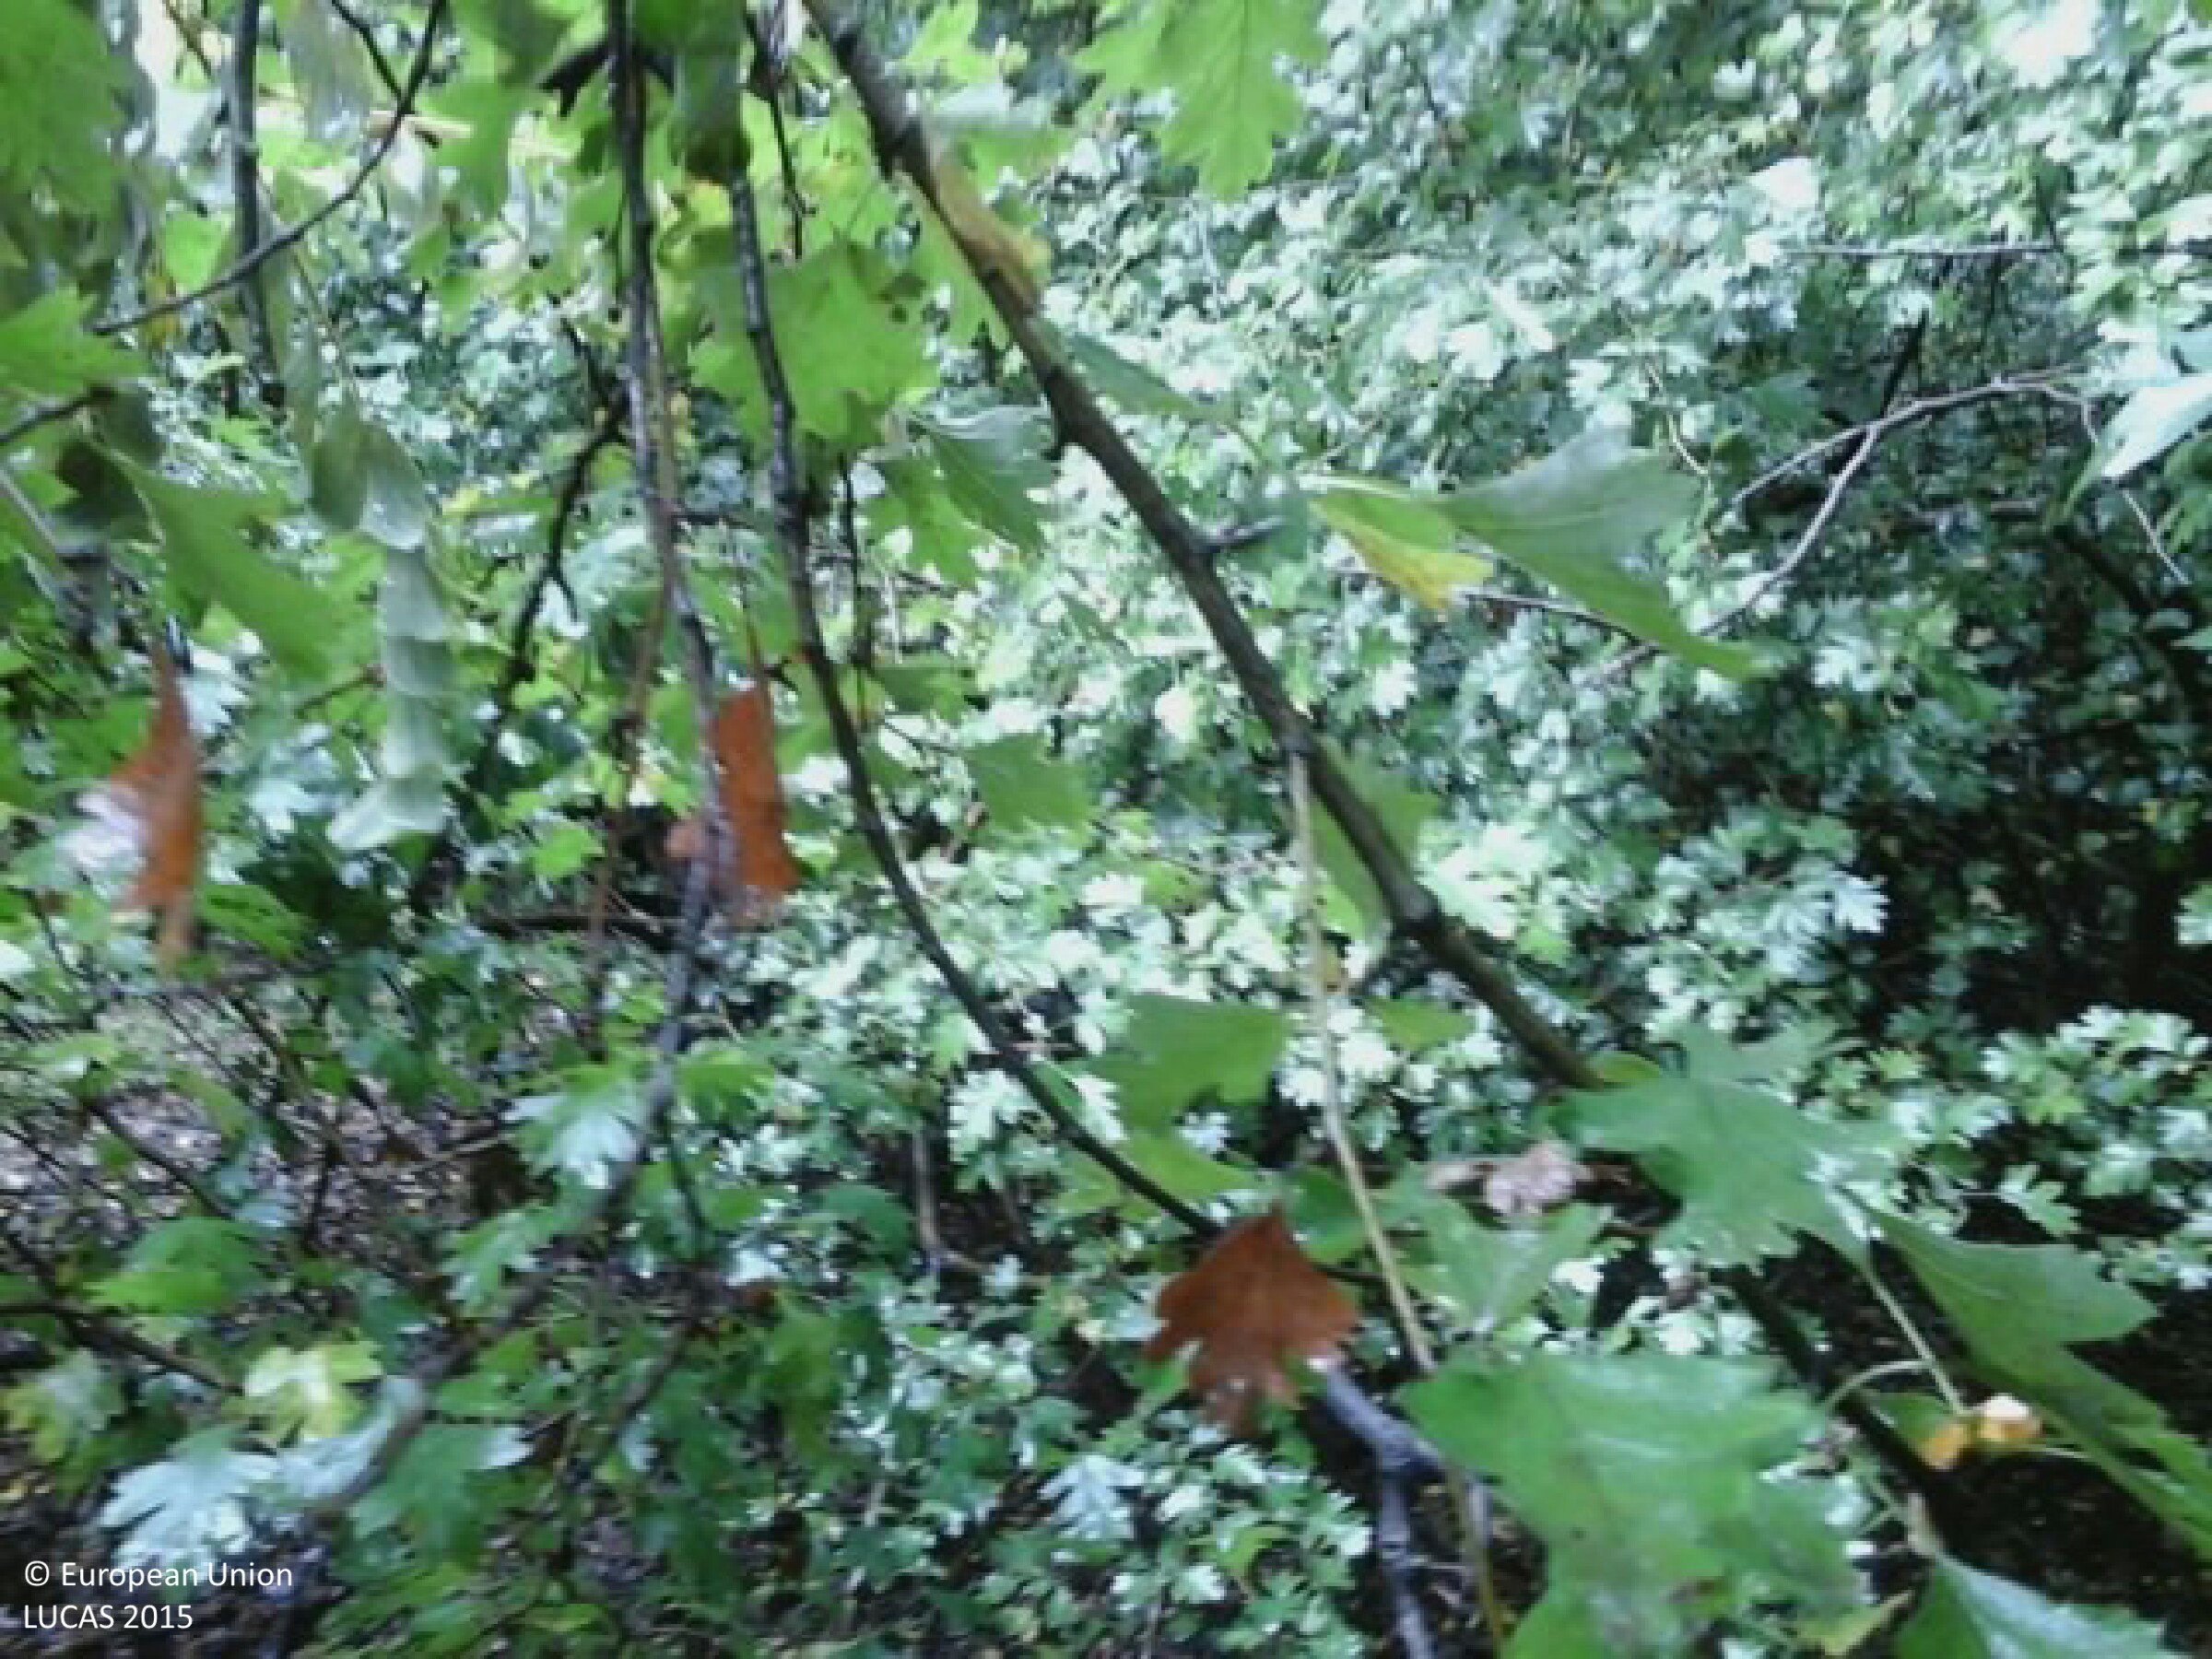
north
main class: Woodland
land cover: Broadleaved woodland
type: thermophilous deciduous forest
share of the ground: > 75 %
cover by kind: broadleaved forest trees 70 %, shrubs 20 %, coniferous forest trees 5 %, herbaceous plants 5 %
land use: Forestry
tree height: > 5 m
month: July
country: HU
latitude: 46.4188
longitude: 18.8467
